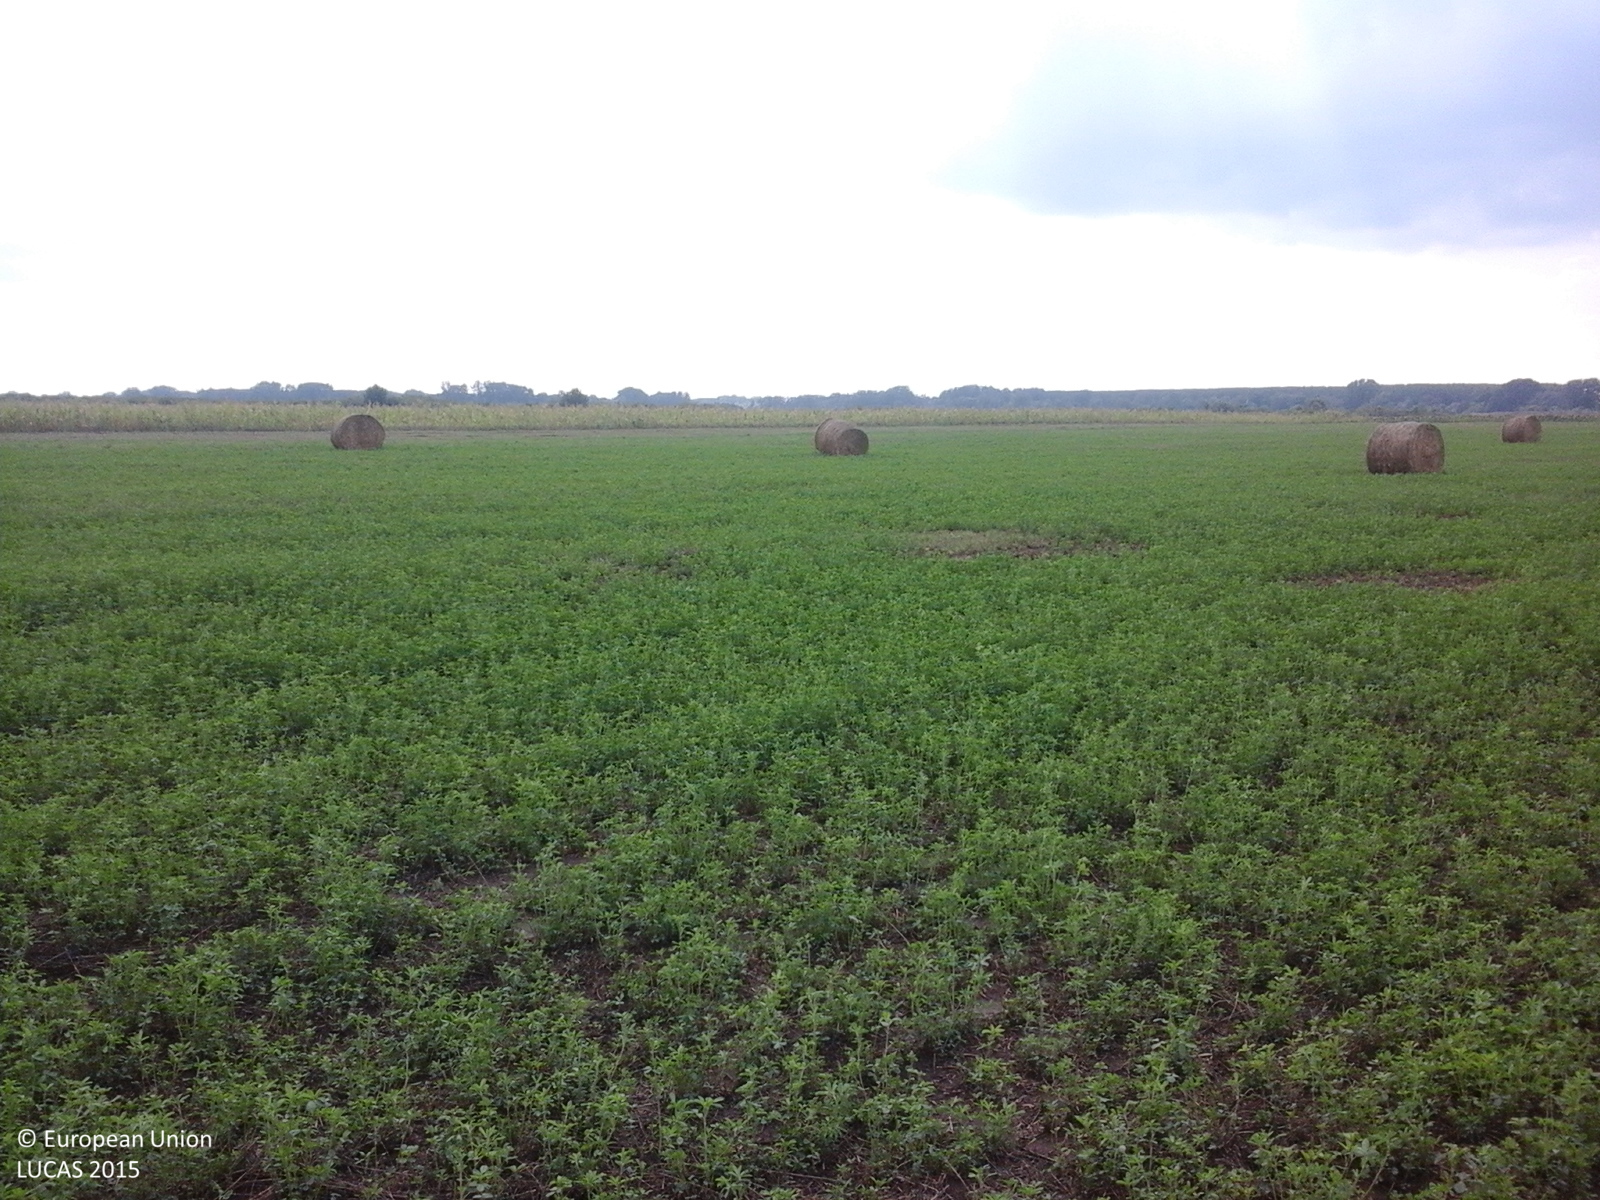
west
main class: Cropland
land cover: Lucerne
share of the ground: > 75 %
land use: Agriculture (excluding fallow land and kitchen gardens)
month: August
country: RO
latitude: 45.4314
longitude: 20.8770
